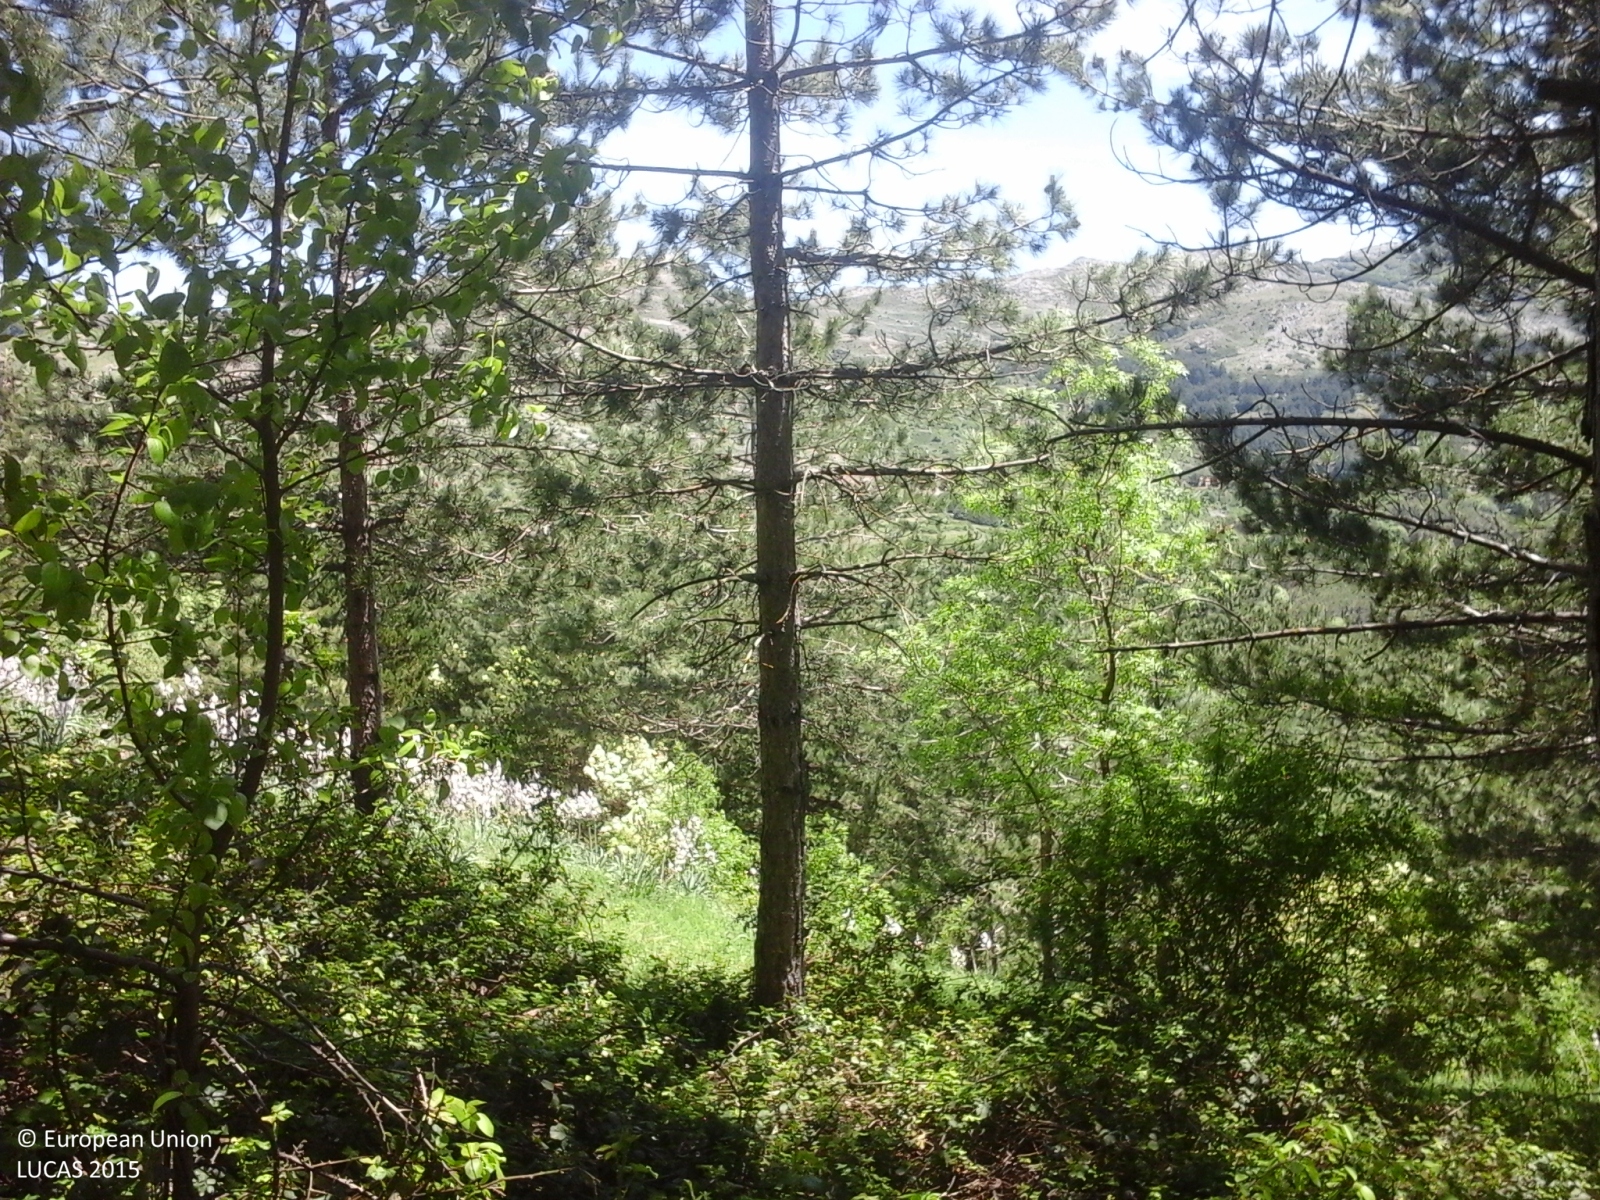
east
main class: Woodland
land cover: Pine dominated coniferous woodland
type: coniferous forest of the mediterranean region
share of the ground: > 75 %
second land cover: Grassland without tree/shrub cover
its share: > 75 %
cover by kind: coniferous forest trees 50 %, herbaceous plants 30 %, shrubs 15 %, broadleaved forest trees 5 %
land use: Forestry
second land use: Agriculture (excluding fallow land and kitchen gardens)
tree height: > 5 m
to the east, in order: Pine dominated coniferous woodland; Grassland without tree/shrub cover; Grassland with sparse tree/shrub cover; Pine dominated coniferous woodland; Grassland with sparse tree/shrub cover; Ditches and canals; Grassland with sparse tree/shrub cover; Pine dominated coniferous woodland
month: May
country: IT
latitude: 37.8591
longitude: 14.0969
